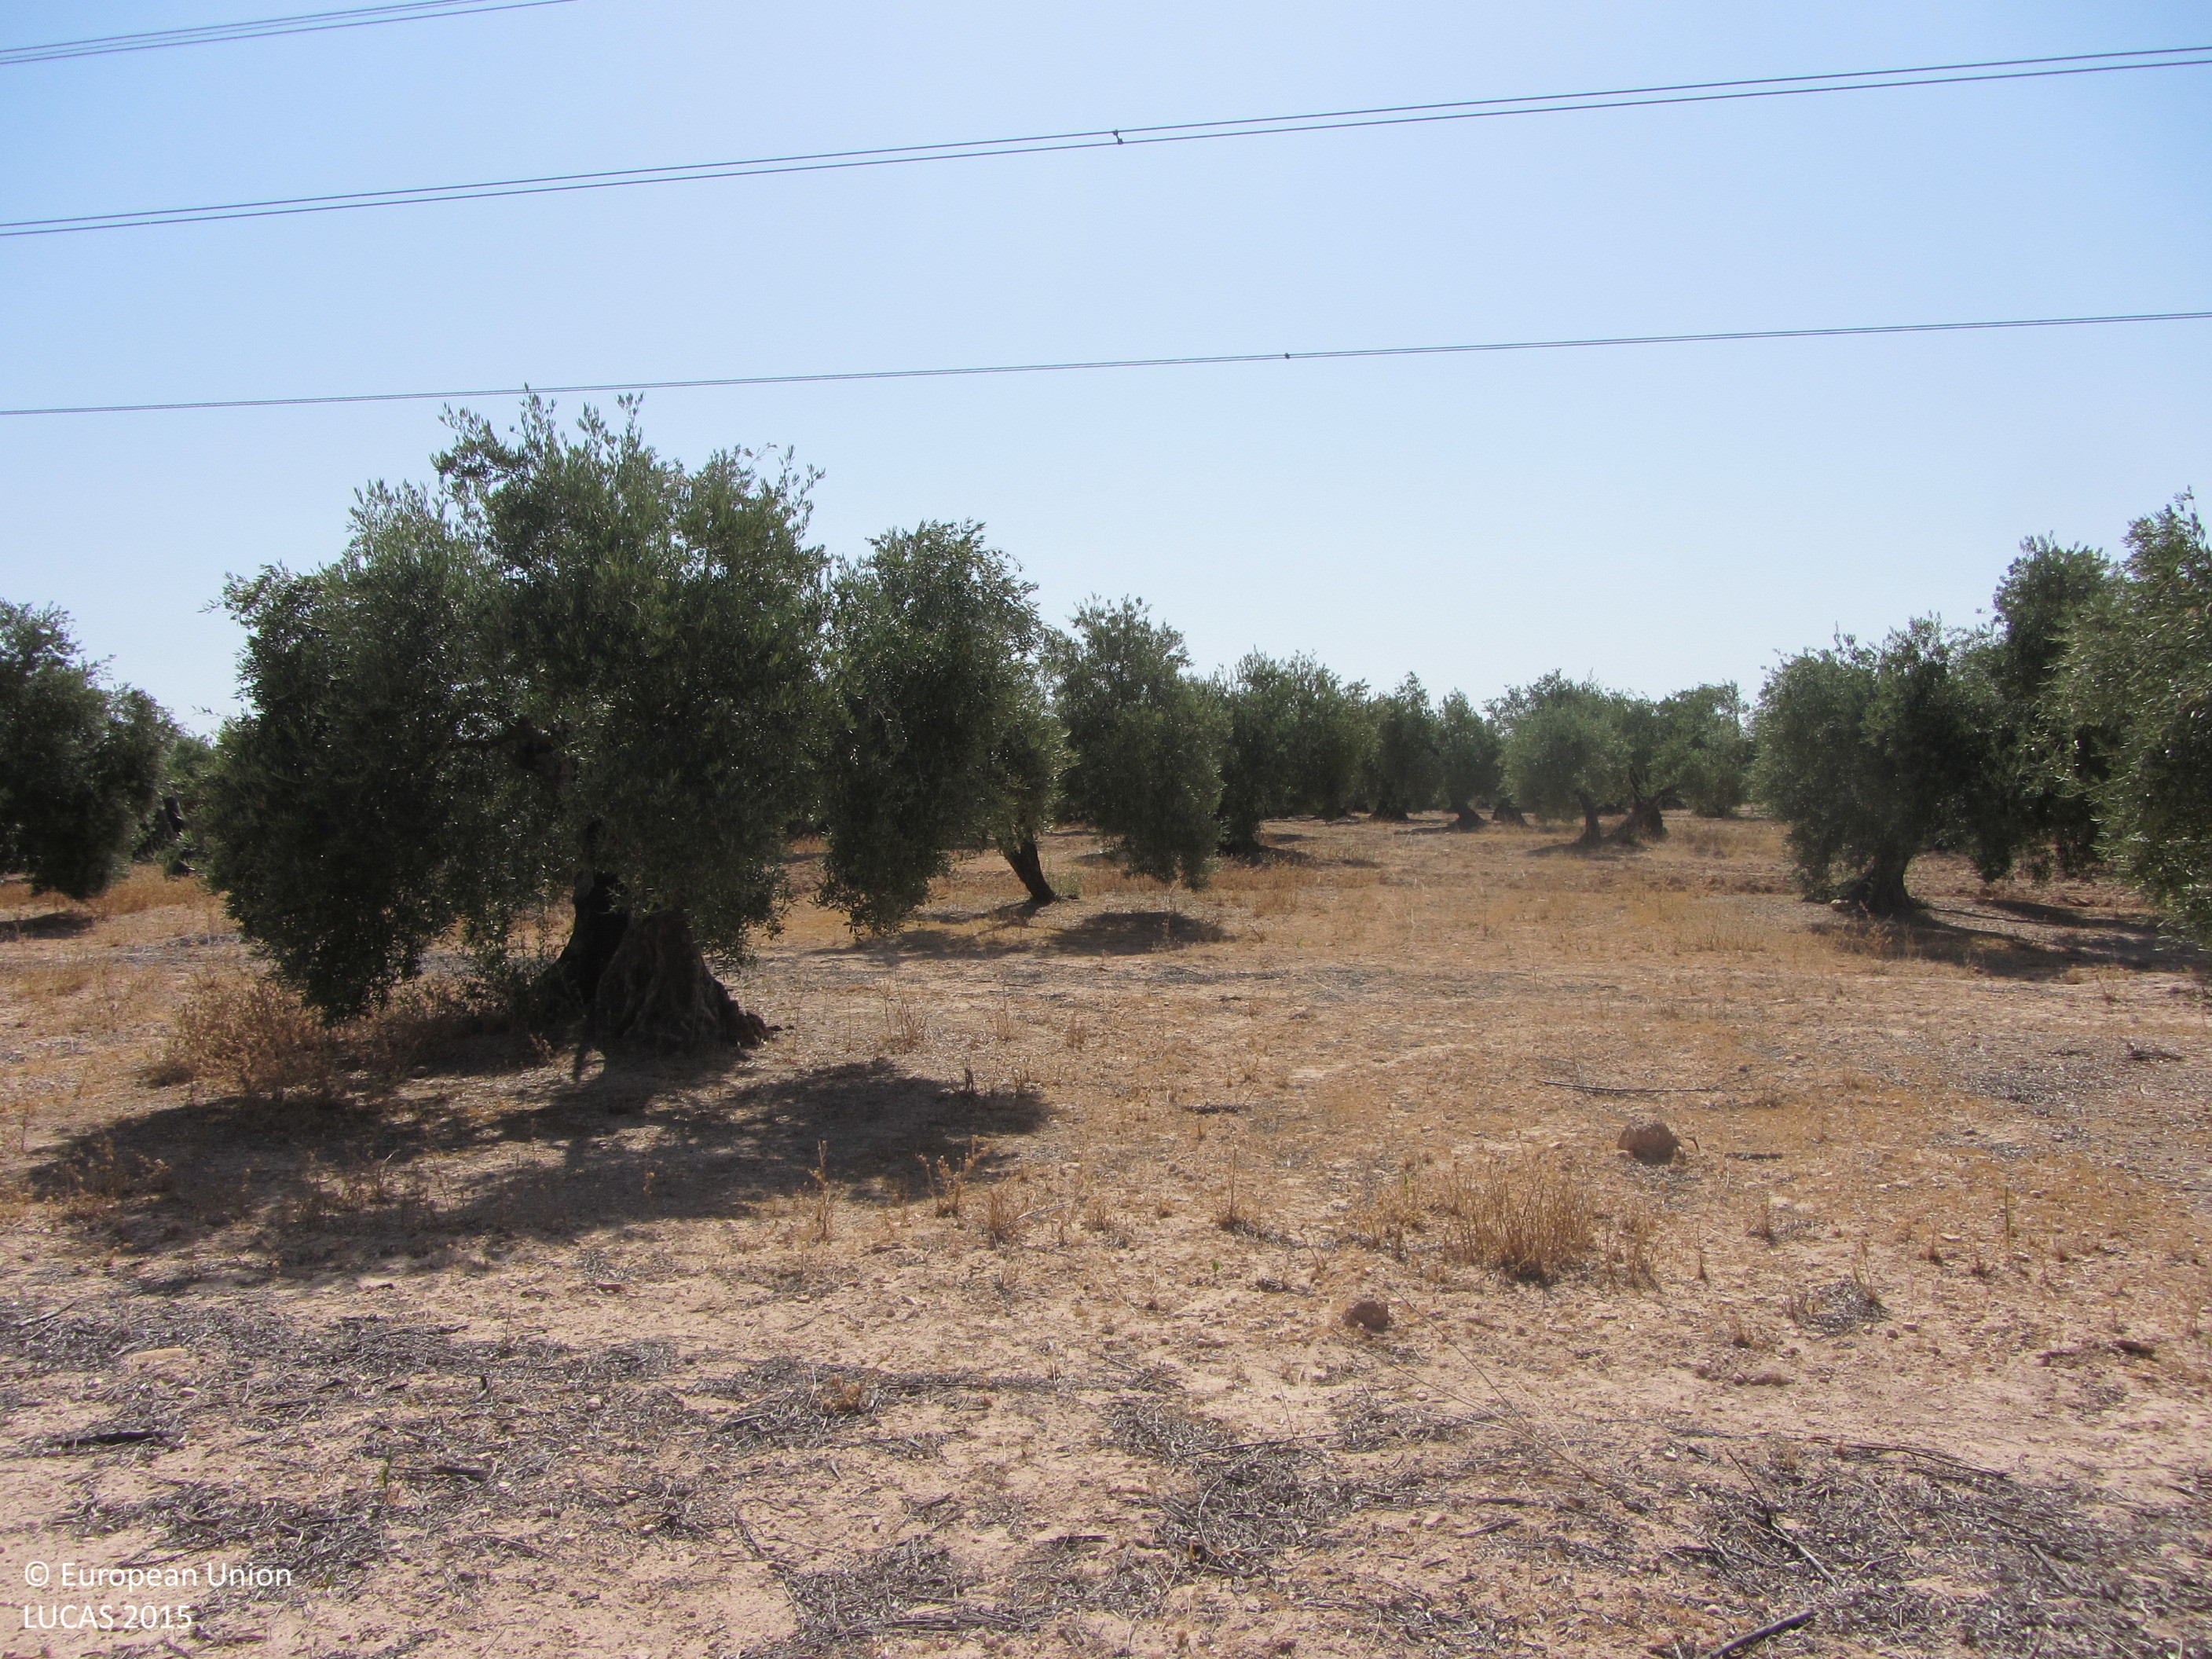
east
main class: Cropland
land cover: Olive groves
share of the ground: 25 - 50 %
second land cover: Other bare soil
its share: > 75 %
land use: Agriculture (excluding fallow land and kitchen gardens)
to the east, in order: Olive groves; Other bare soil; Electric lines; Olive groves
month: July
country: ES
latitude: 37.9976
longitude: -4.2093
